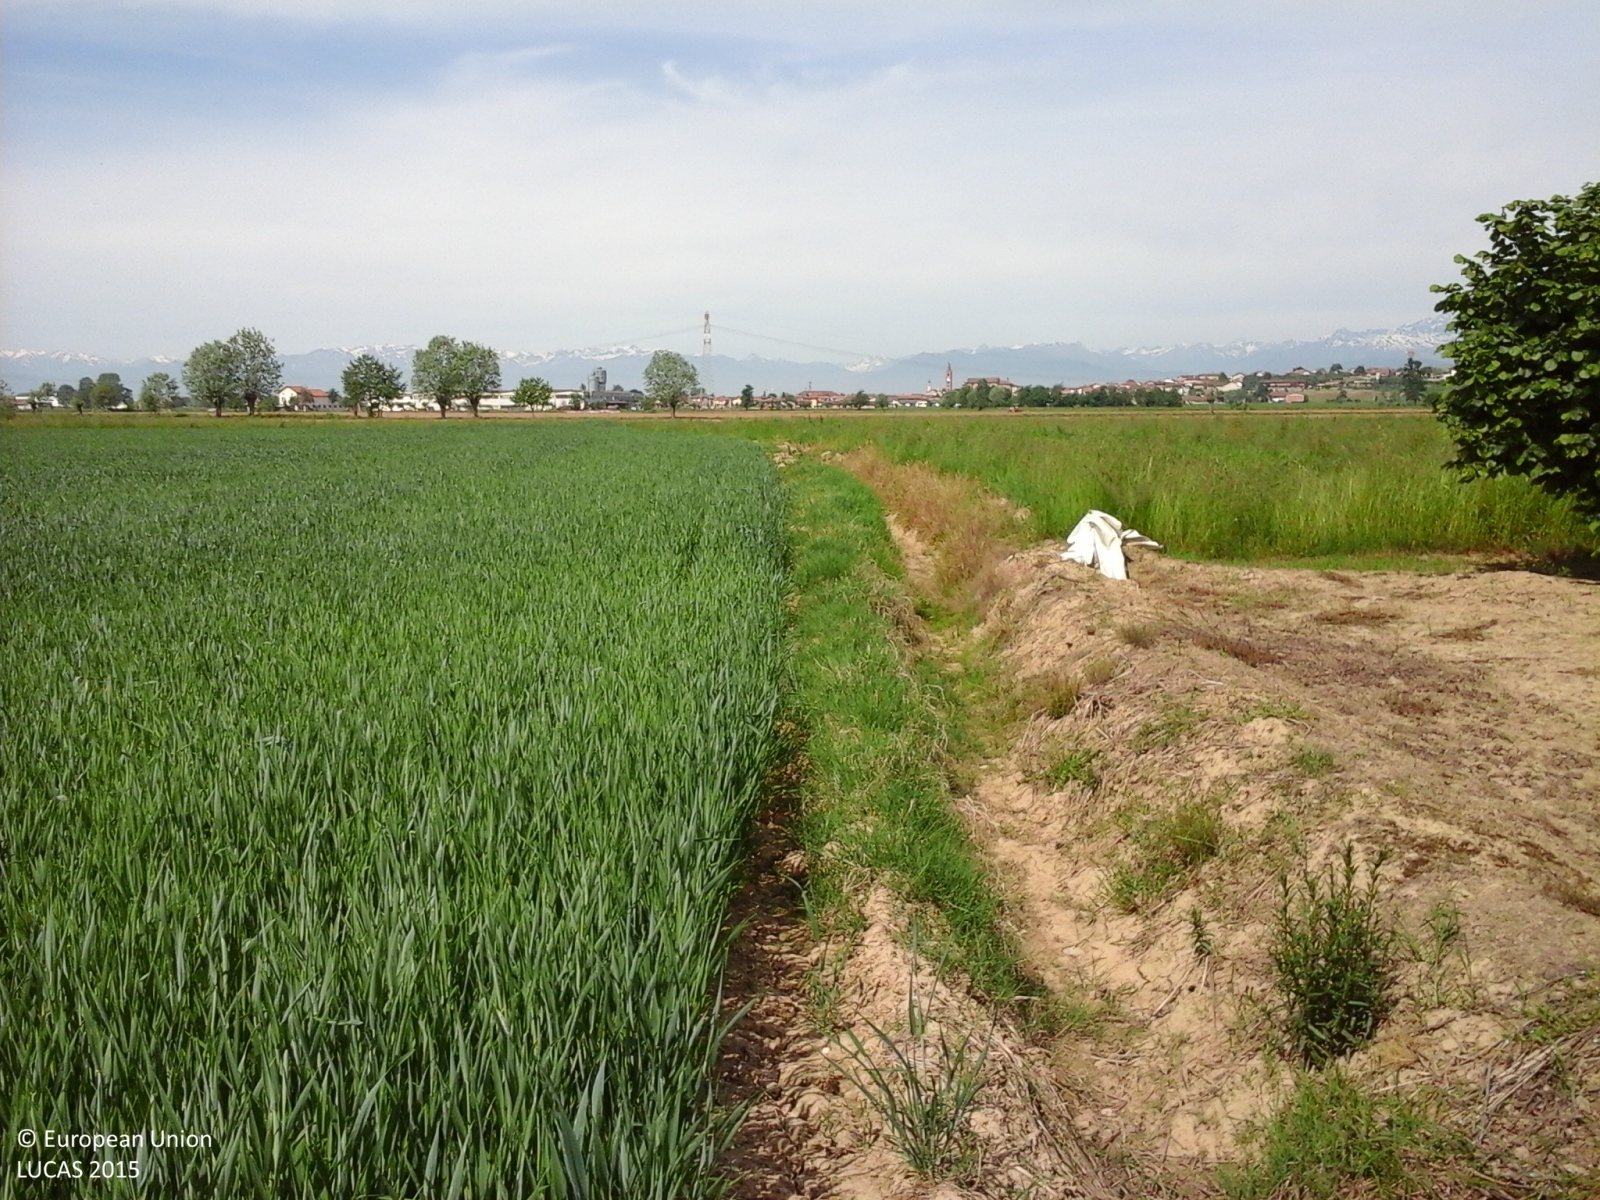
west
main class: Cropland
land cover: Common wheat
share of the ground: > 75 %
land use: Agriculture (excluding fallow land and kitchen gardens)
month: May
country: IT
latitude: 44.5072
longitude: 7.7782
